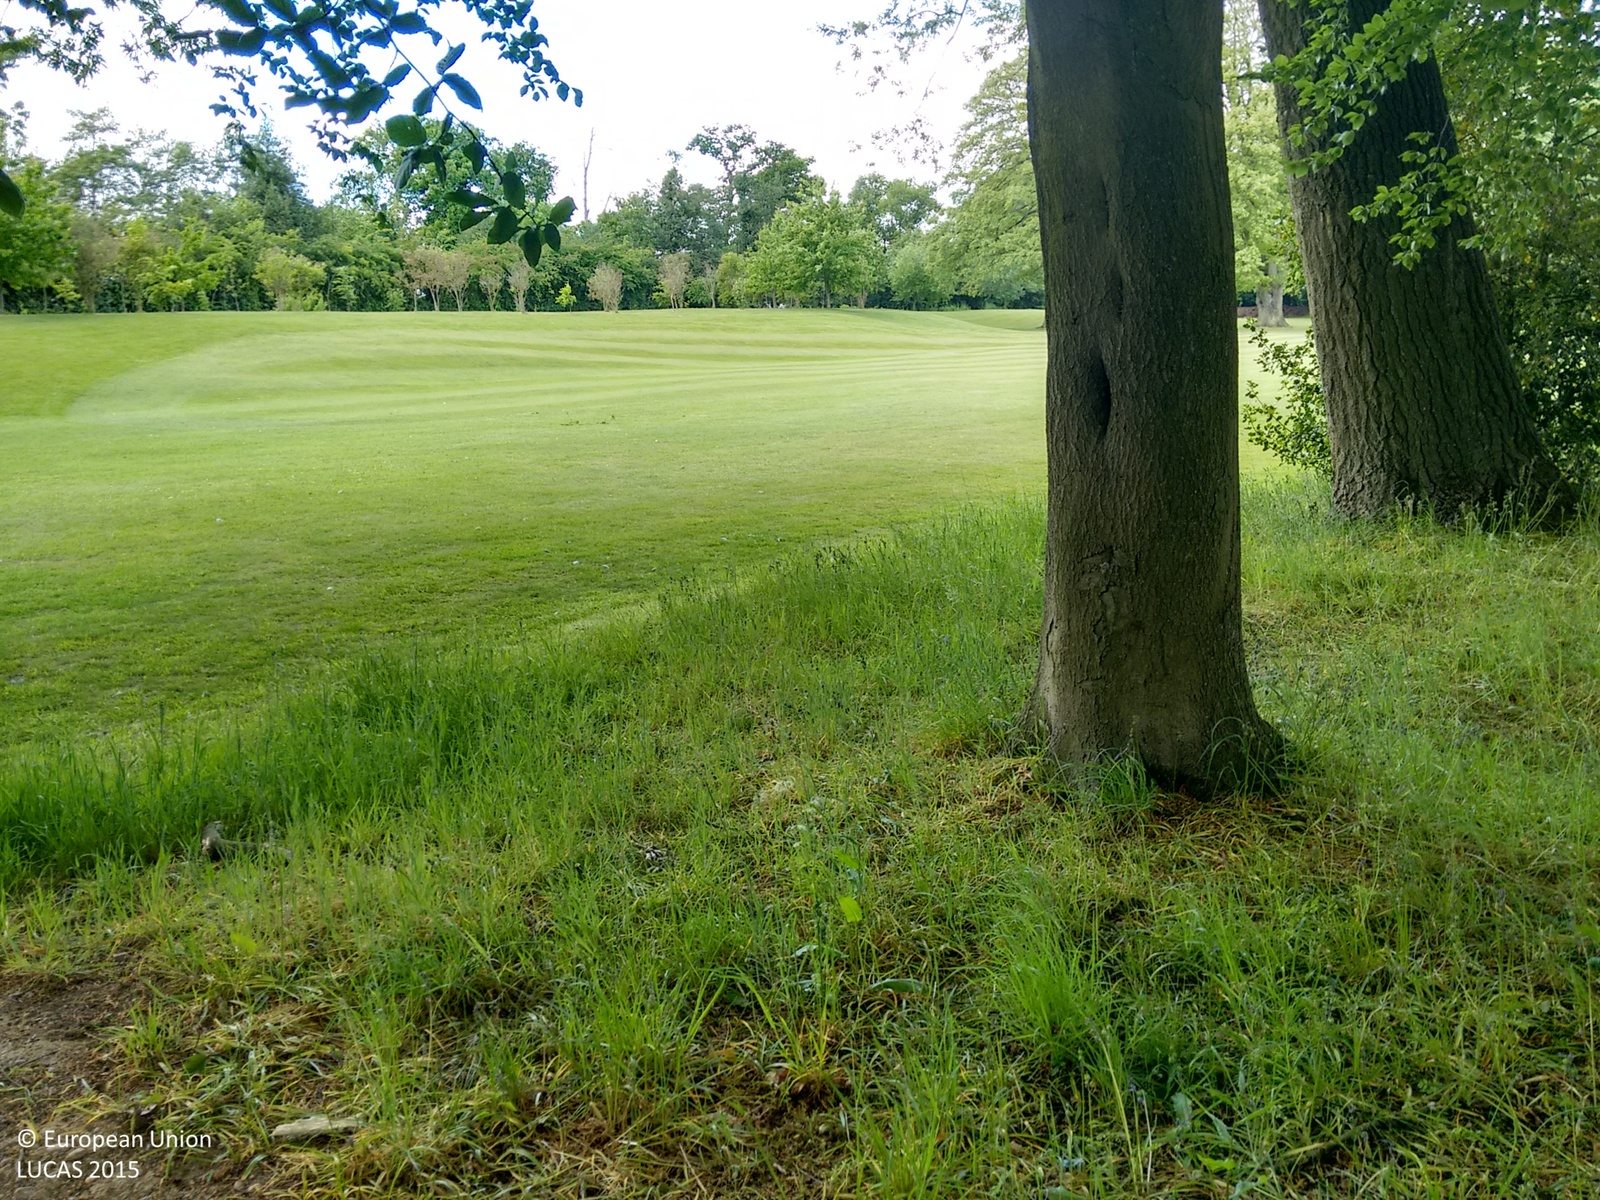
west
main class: Woodland
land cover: Broadleaved woodland
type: mesophytic deciduous forest
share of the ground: > 75 %
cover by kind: broadleaved forest trees 95 %, herbaceous plants 5 %
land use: Sport
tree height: > 5 m
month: June
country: GB
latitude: 52.2864
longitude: -1.7085
